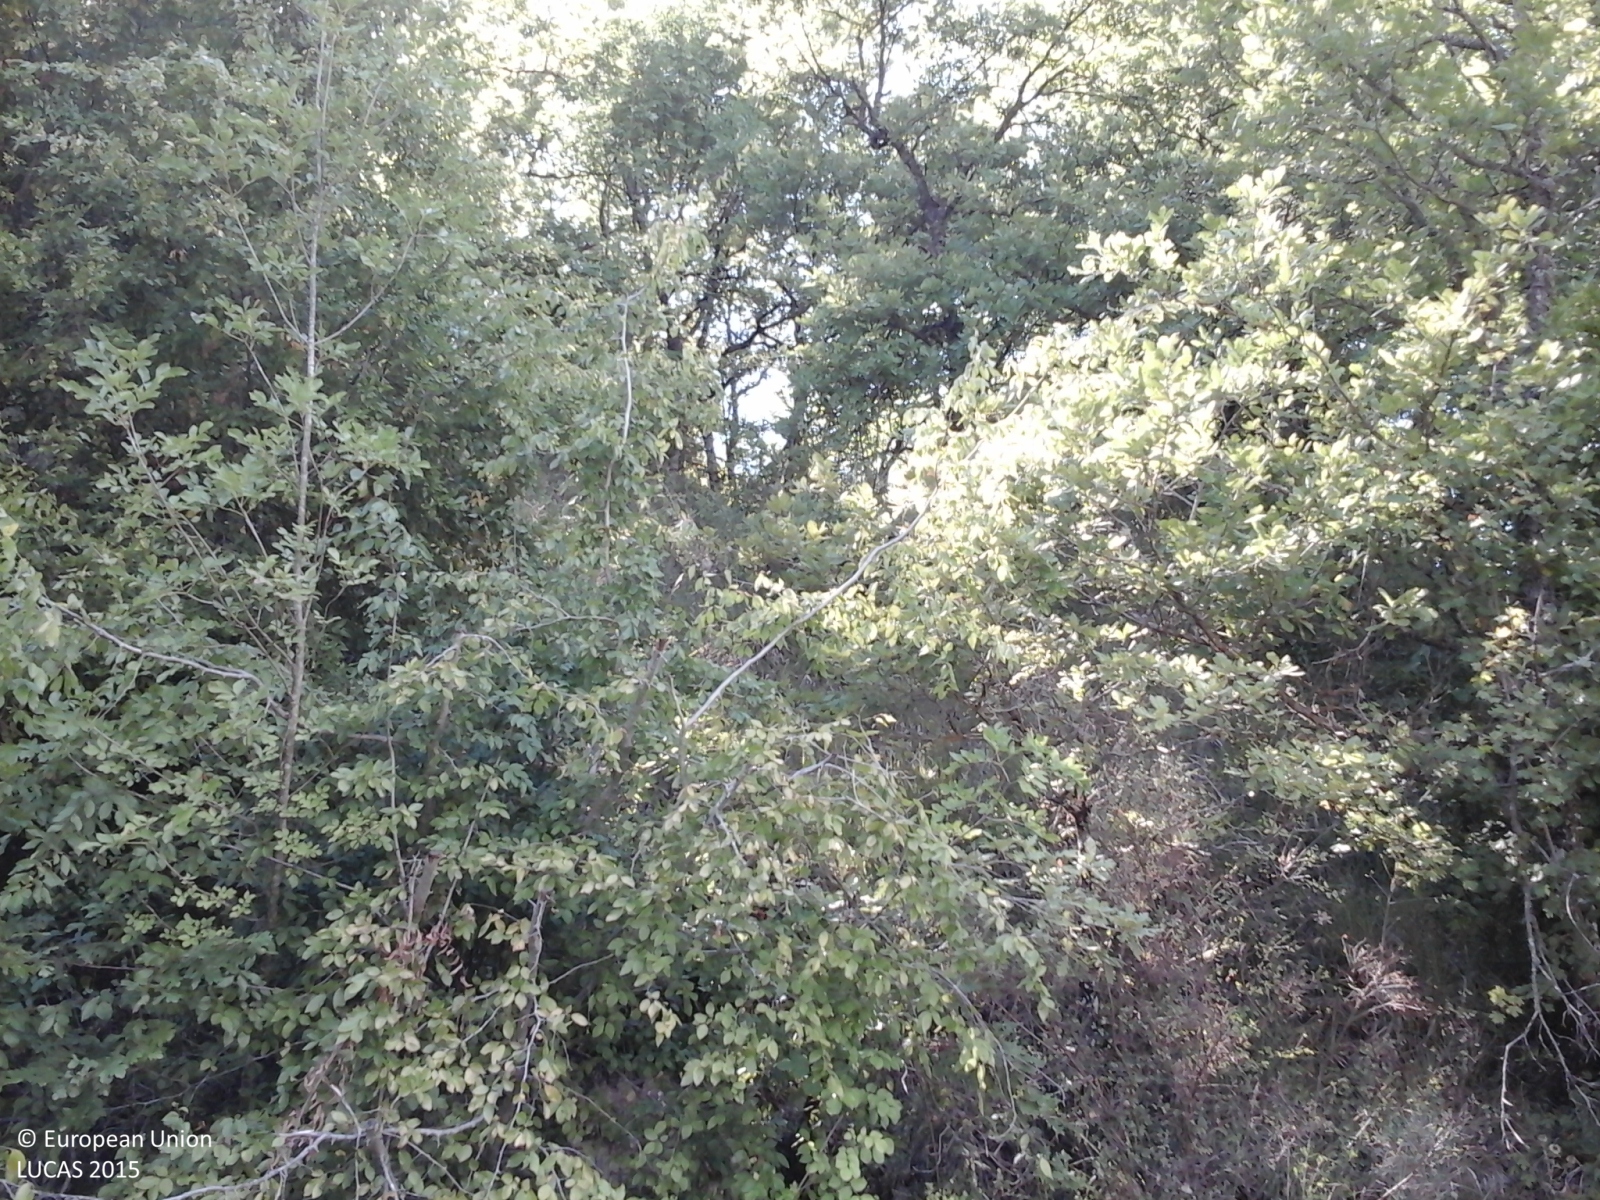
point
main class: Woodland
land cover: Broadleaved woodland
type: thermophilous deciduous forest
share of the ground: > 75 %
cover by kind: broadleaved forest trees 85 %, shrubs 10 %, herbaceous plants 5 %
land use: Semi-natural and natural areas not in use
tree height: > 5 m
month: August
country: IT
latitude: 41.5661
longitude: 14.3375
